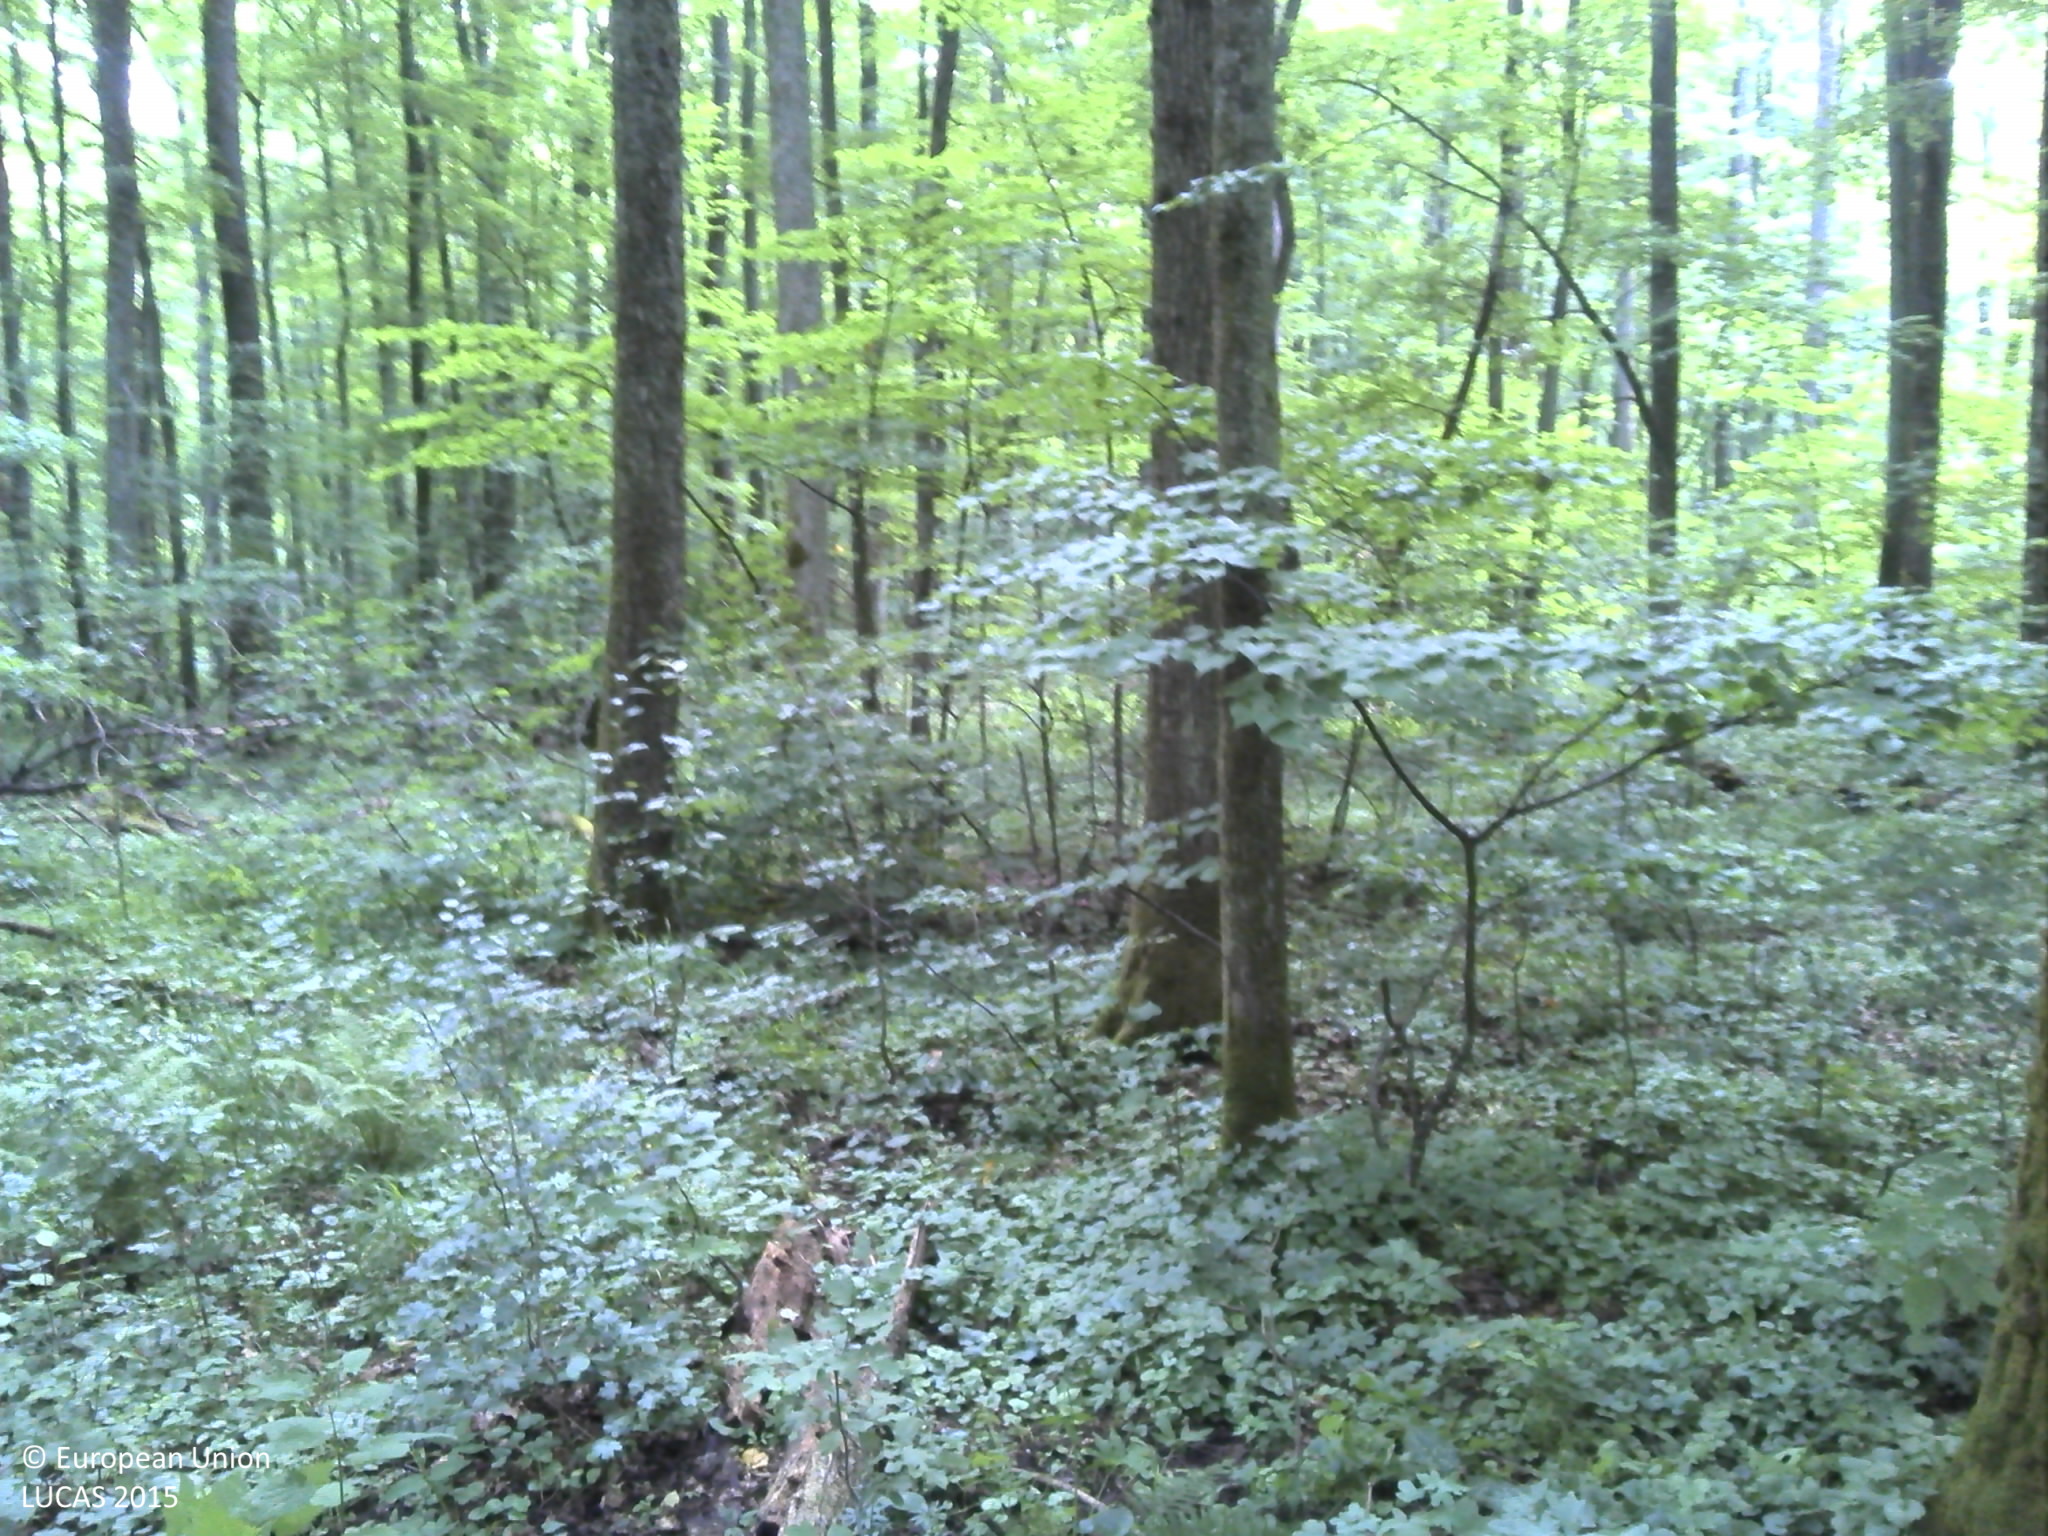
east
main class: Woodland
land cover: Broadleaved woodland
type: beech forest
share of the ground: > 75 %
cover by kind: broadleaved forest trees 100 %
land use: Forestry
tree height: > 5 m
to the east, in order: Broadleaved woodland
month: June
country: HR
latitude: 45.6691
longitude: 18.0271
